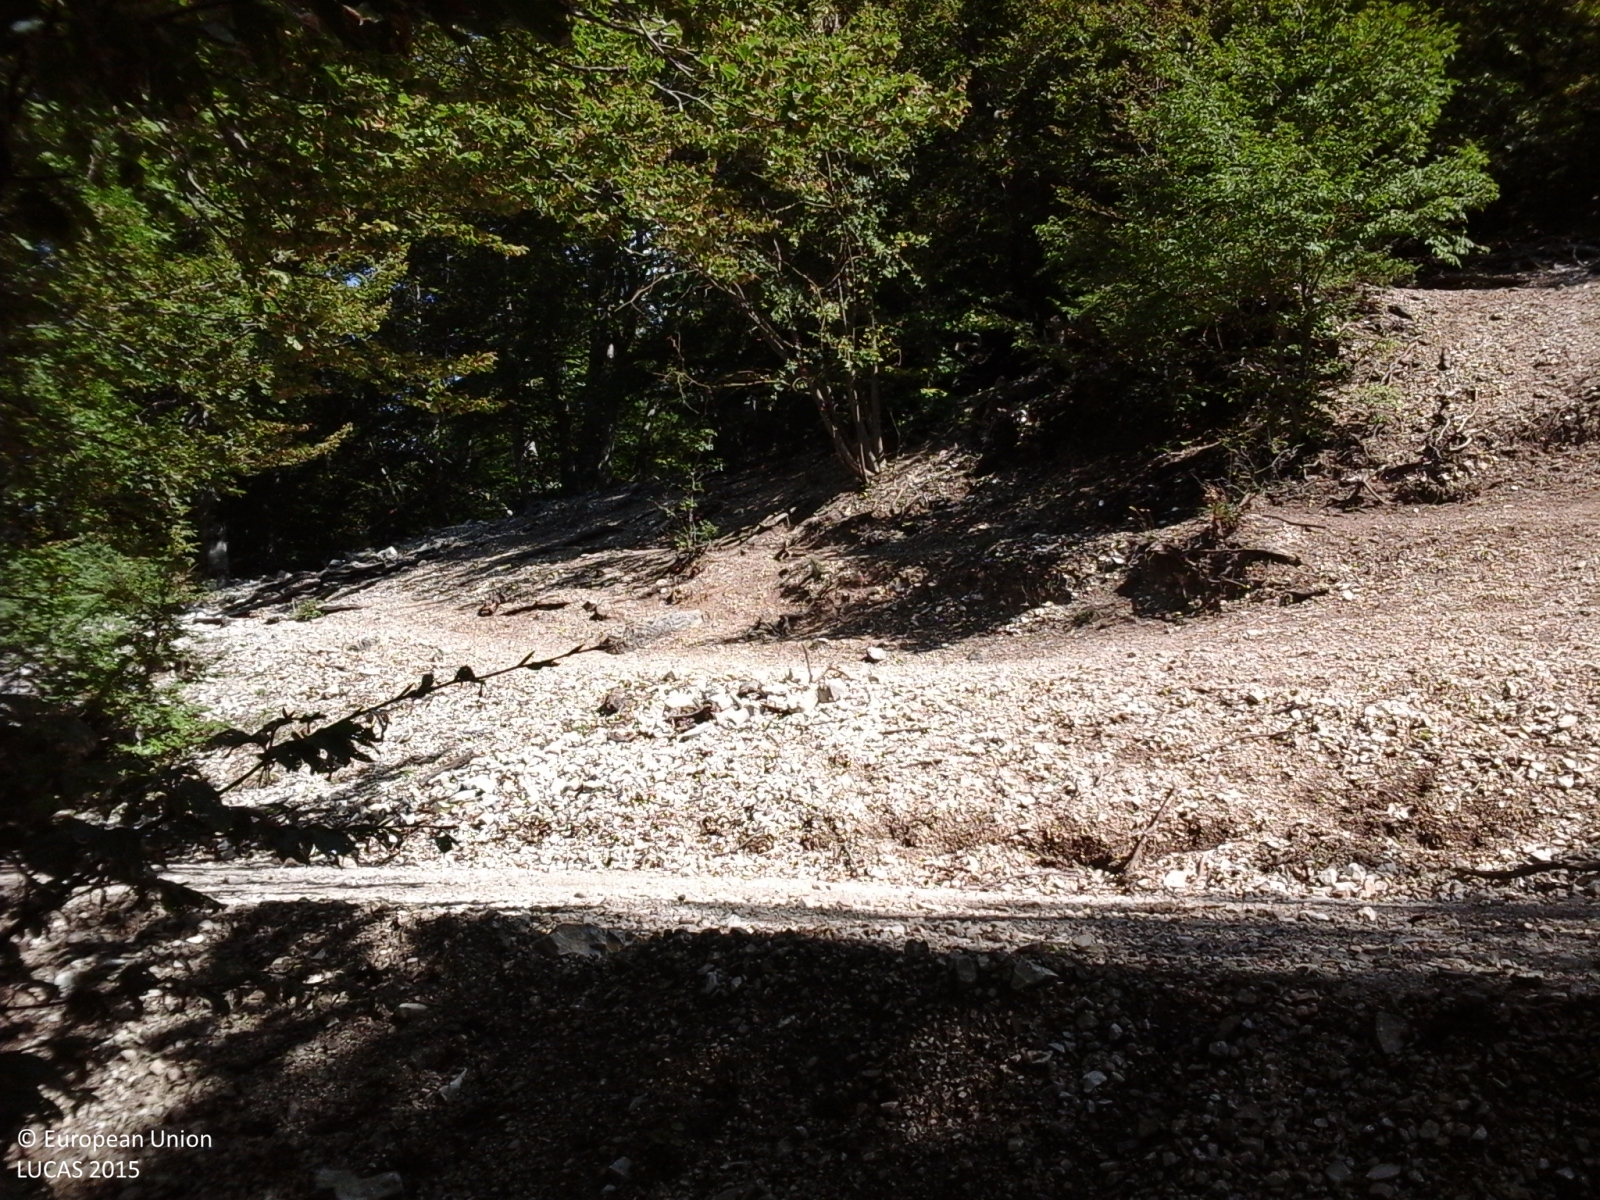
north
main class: Woodland
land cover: Broadleaved woodland
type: mountainous beech forest
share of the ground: > 75 %
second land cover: Grassland without tree/shrub cover
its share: < 10 %
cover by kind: broadleaved forest trees 90 %, herbaceous plants 10 %
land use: Forestry
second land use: Agriculture (excluding fallow land and kitchen gardens)
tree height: > 5 m
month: August
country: IT
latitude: 42.8577
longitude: 13.1605
